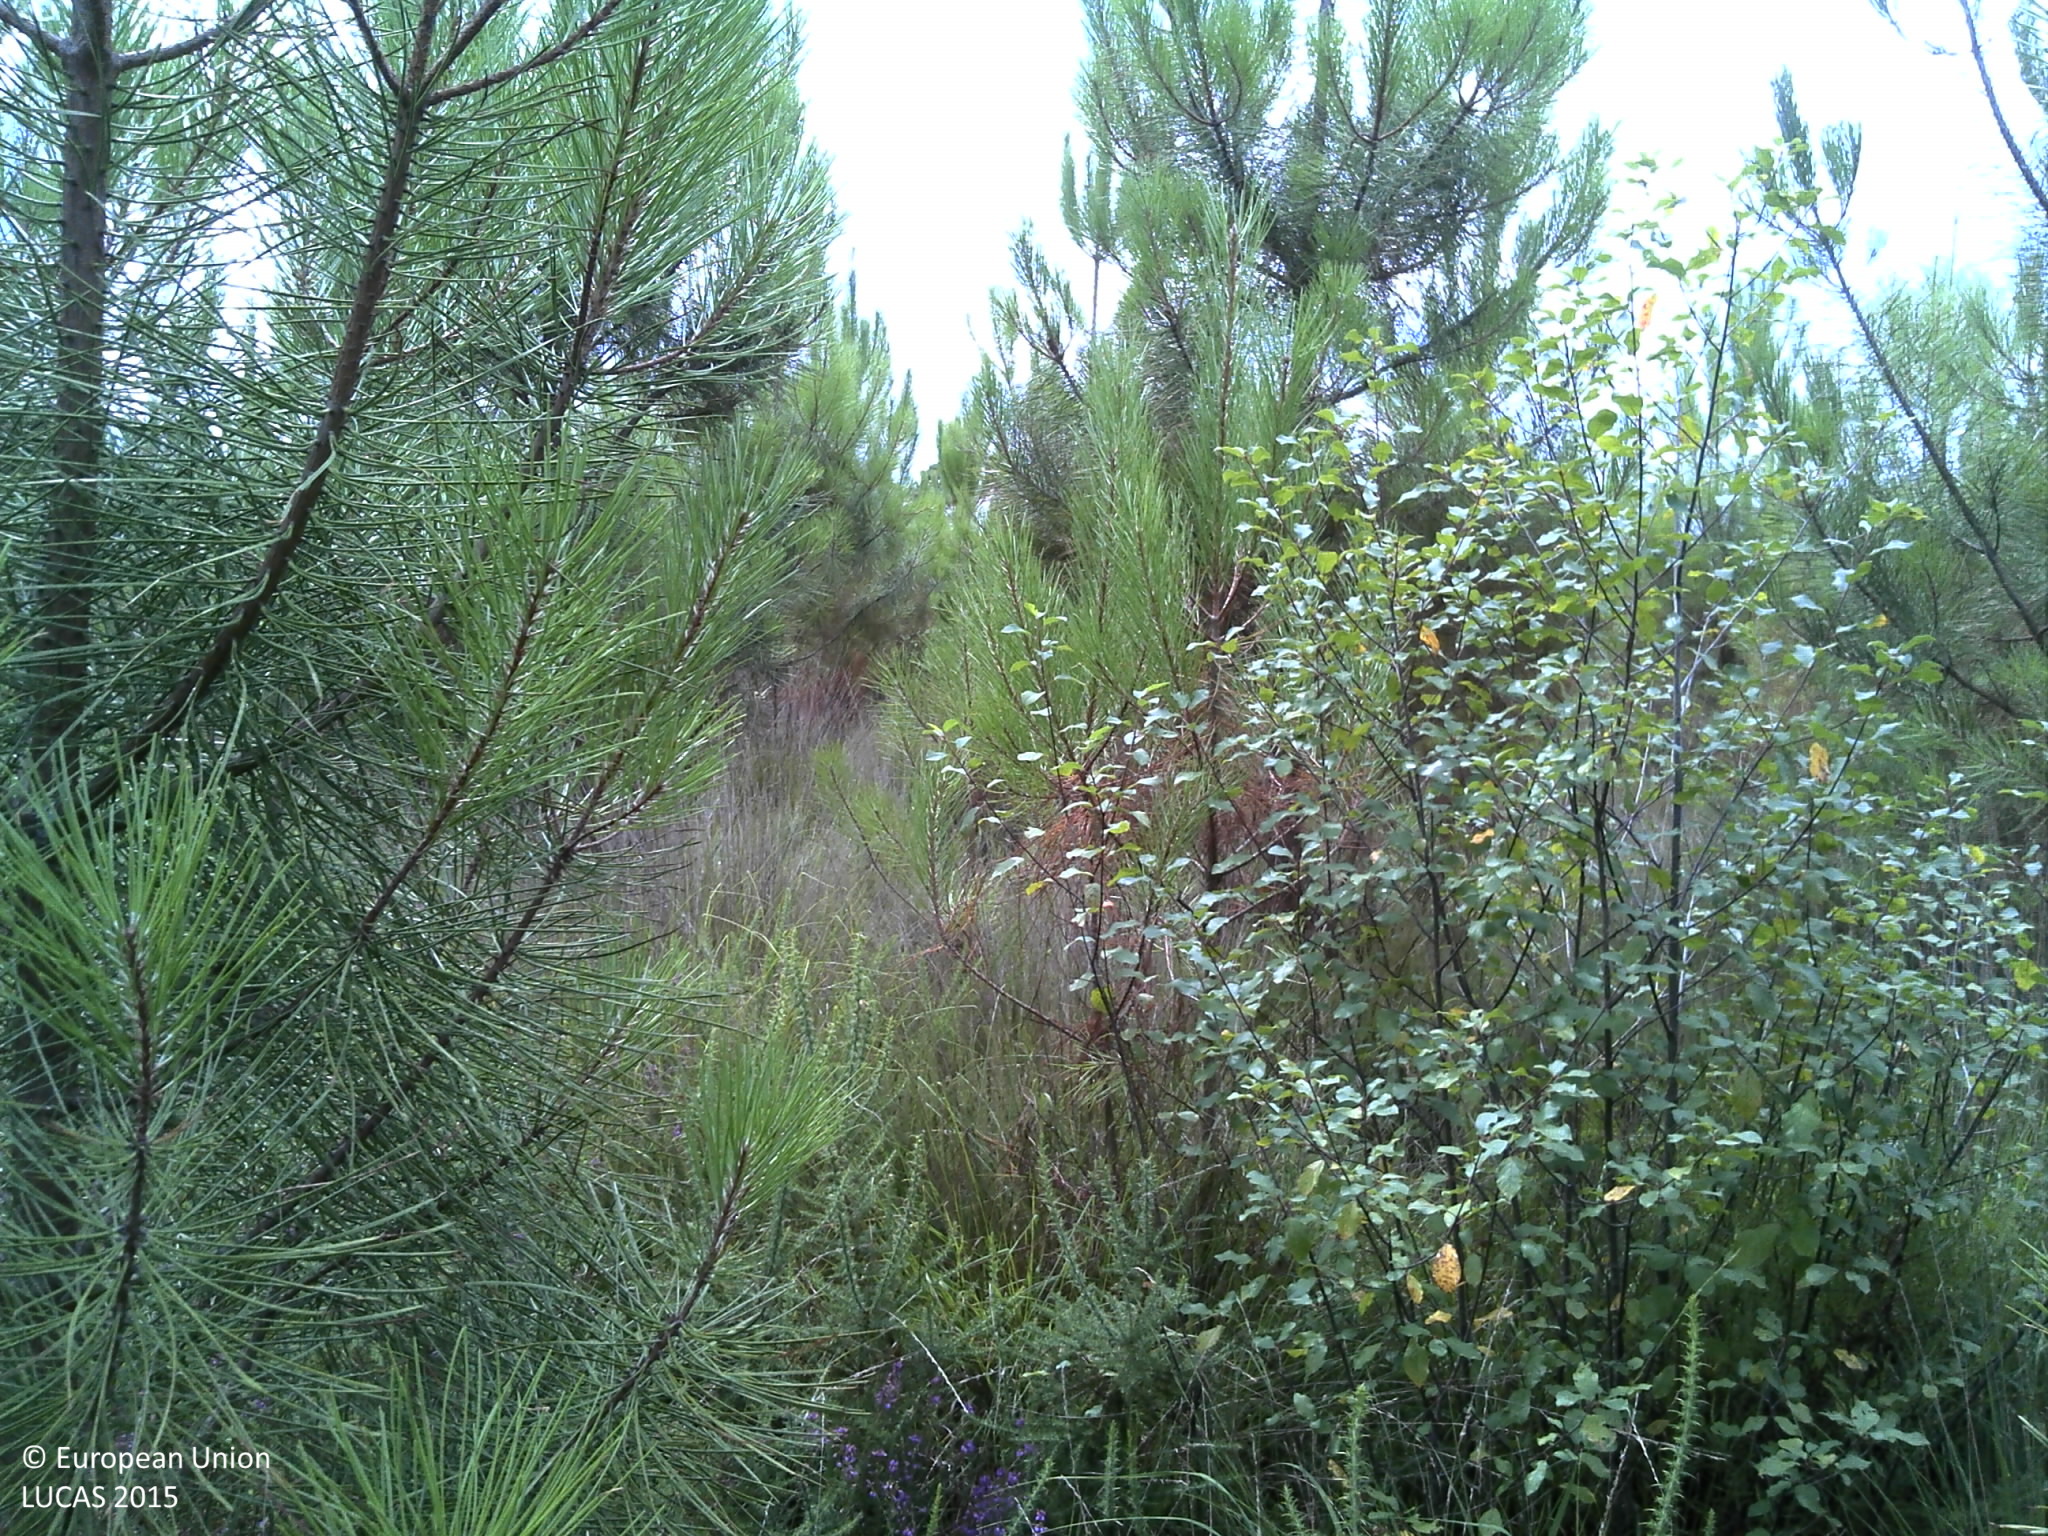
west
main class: Woodland
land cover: Pine dominated coniferous woodland
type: coniferous forest of the mediterranean region
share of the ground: 50 - 75 %
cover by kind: coniferous forest trees 60 %, shrubs 30 %, herbaceous plants 5 %, lichens and mosses 5 %
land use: Forestry
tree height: > 5 m
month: July
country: FR
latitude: 44.4948
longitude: -0.4406
